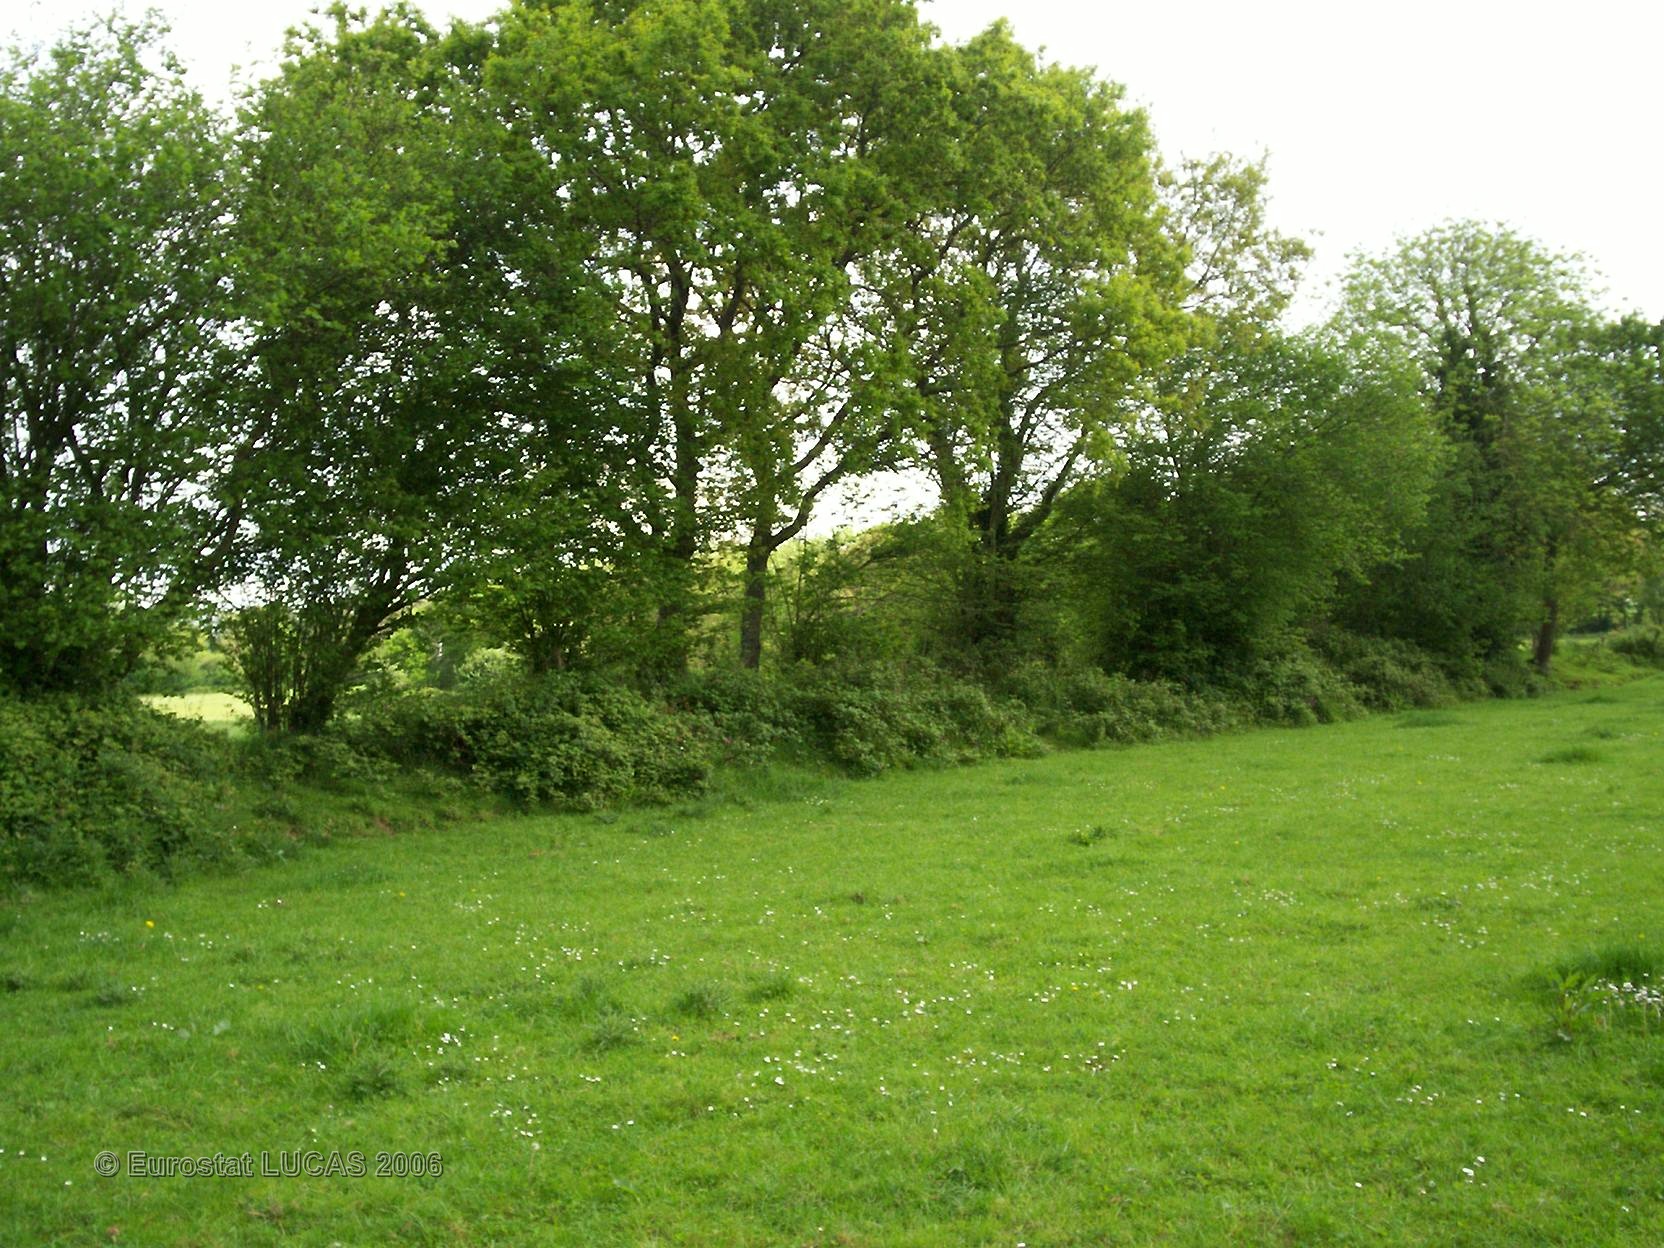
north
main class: Grassland
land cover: Grassland without tree/shrub cover
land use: Agriculture (excluding fallow land and kitchen gardens)
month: May
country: FR
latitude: 48.5749
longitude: -3.7875
